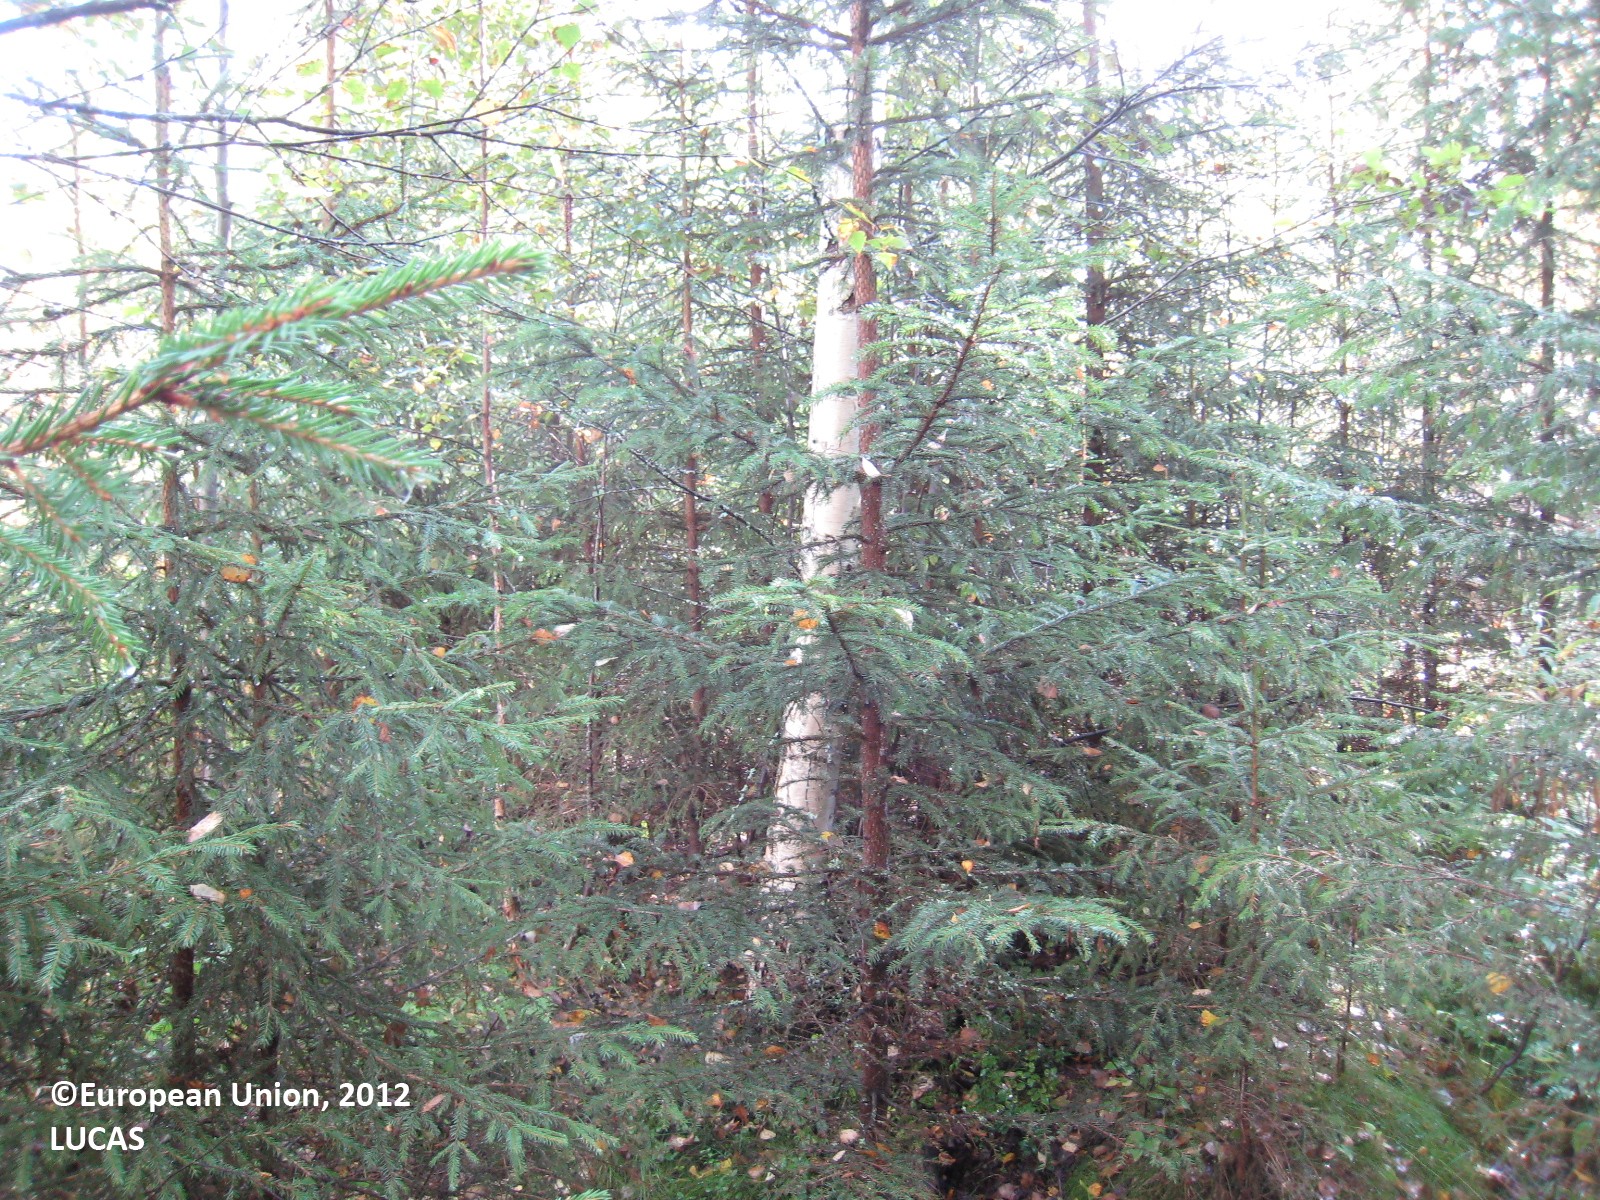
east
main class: Woodland
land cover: Spruce dominated mixed woodland
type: boreal forest
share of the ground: > 75 %
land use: Forestry
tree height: > 5 m
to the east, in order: Spruce dominated mixed woodland; Other mixed woodland; Ditches and canals; Groves; Tracks; Electric lines; Spruce dominated mixed woodland; Ditches and canals; Spruce dominated mixed woodland; Ditches and canals; Spruce dominated mixed woodland; Ditches and canals; Spruce dominated mixed woodland; Ditches and canals; Other mixed woodland; Ditches and canals; Other coniferous woodland; Ditches and canals; Other coniferous woodland; Ditches and canals; Pine dominated coniferous woodland; Ditches and canals; Other mixed woodland; Ditches and canals; Other mixed woodland
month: September
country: FI
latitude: 63.1110
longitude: 26.7257
